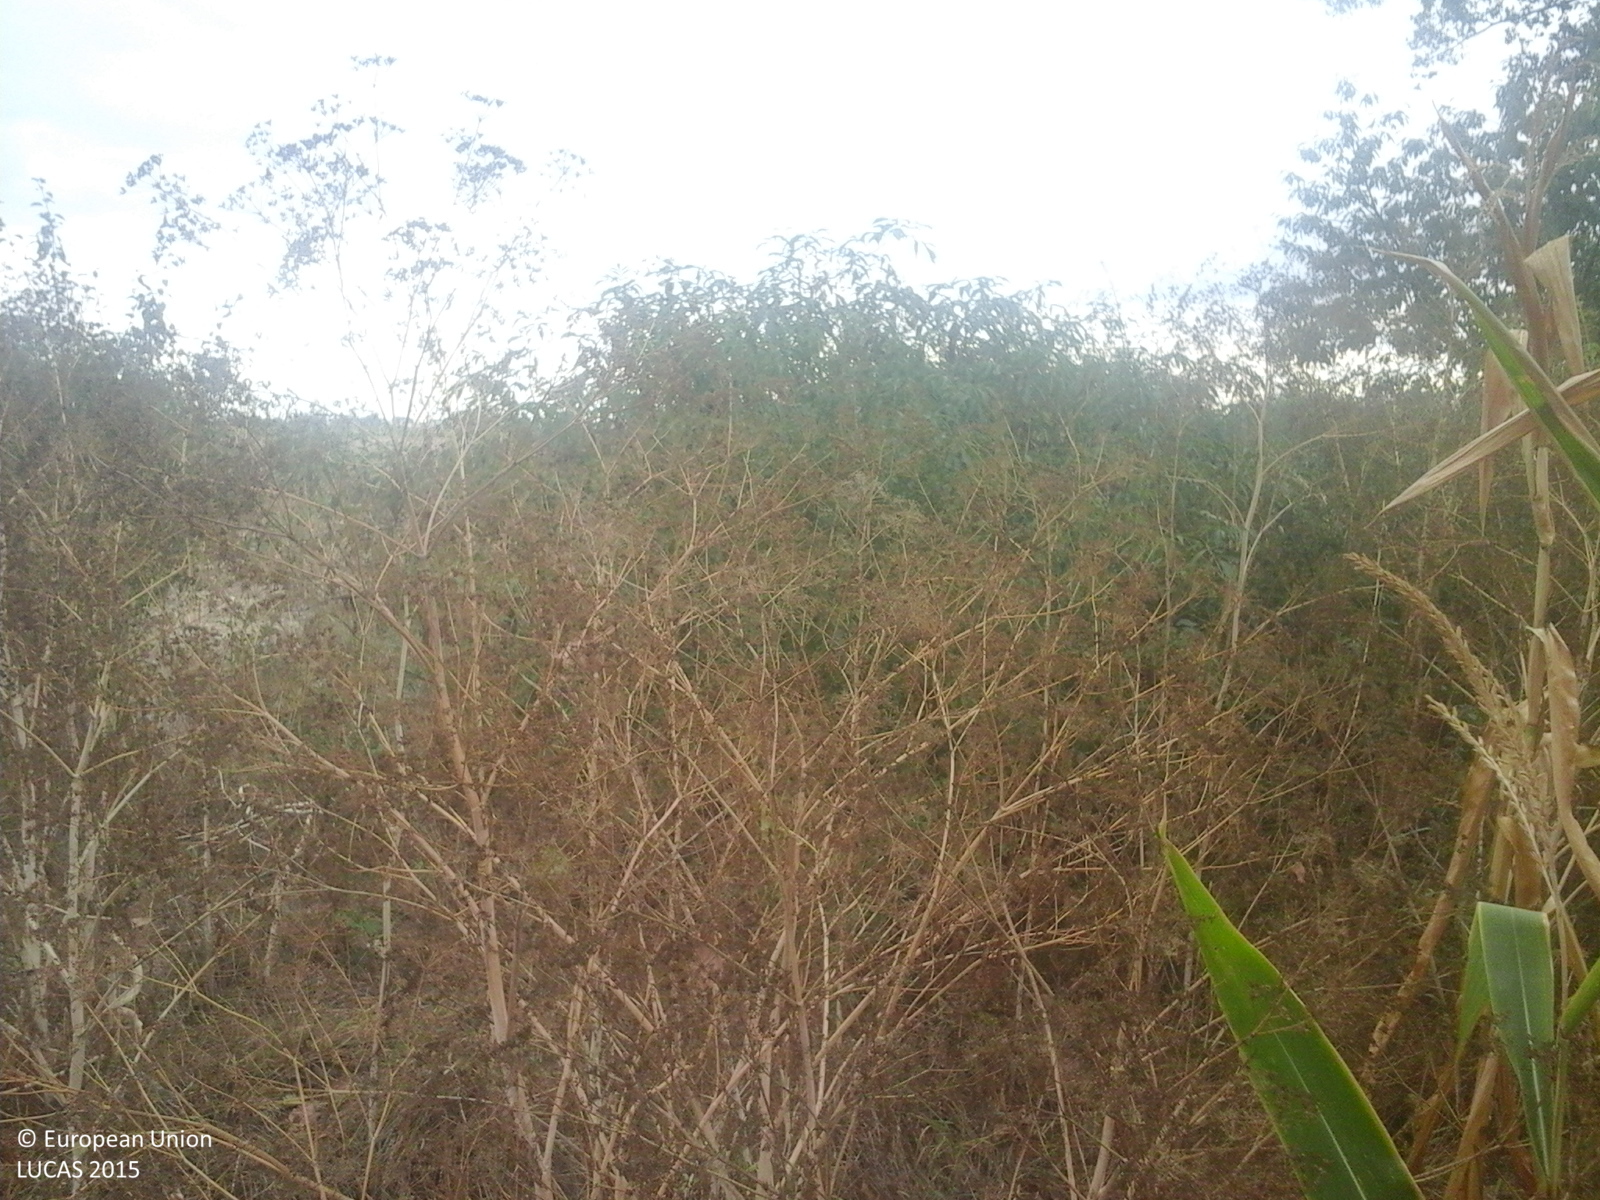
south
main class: Cropland
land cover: Maize
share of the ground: > 75 %
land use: Agriculture (excluding fallow land and kitchen gardens)
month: September
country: RO
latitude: 47.8322
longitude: 22.8493
